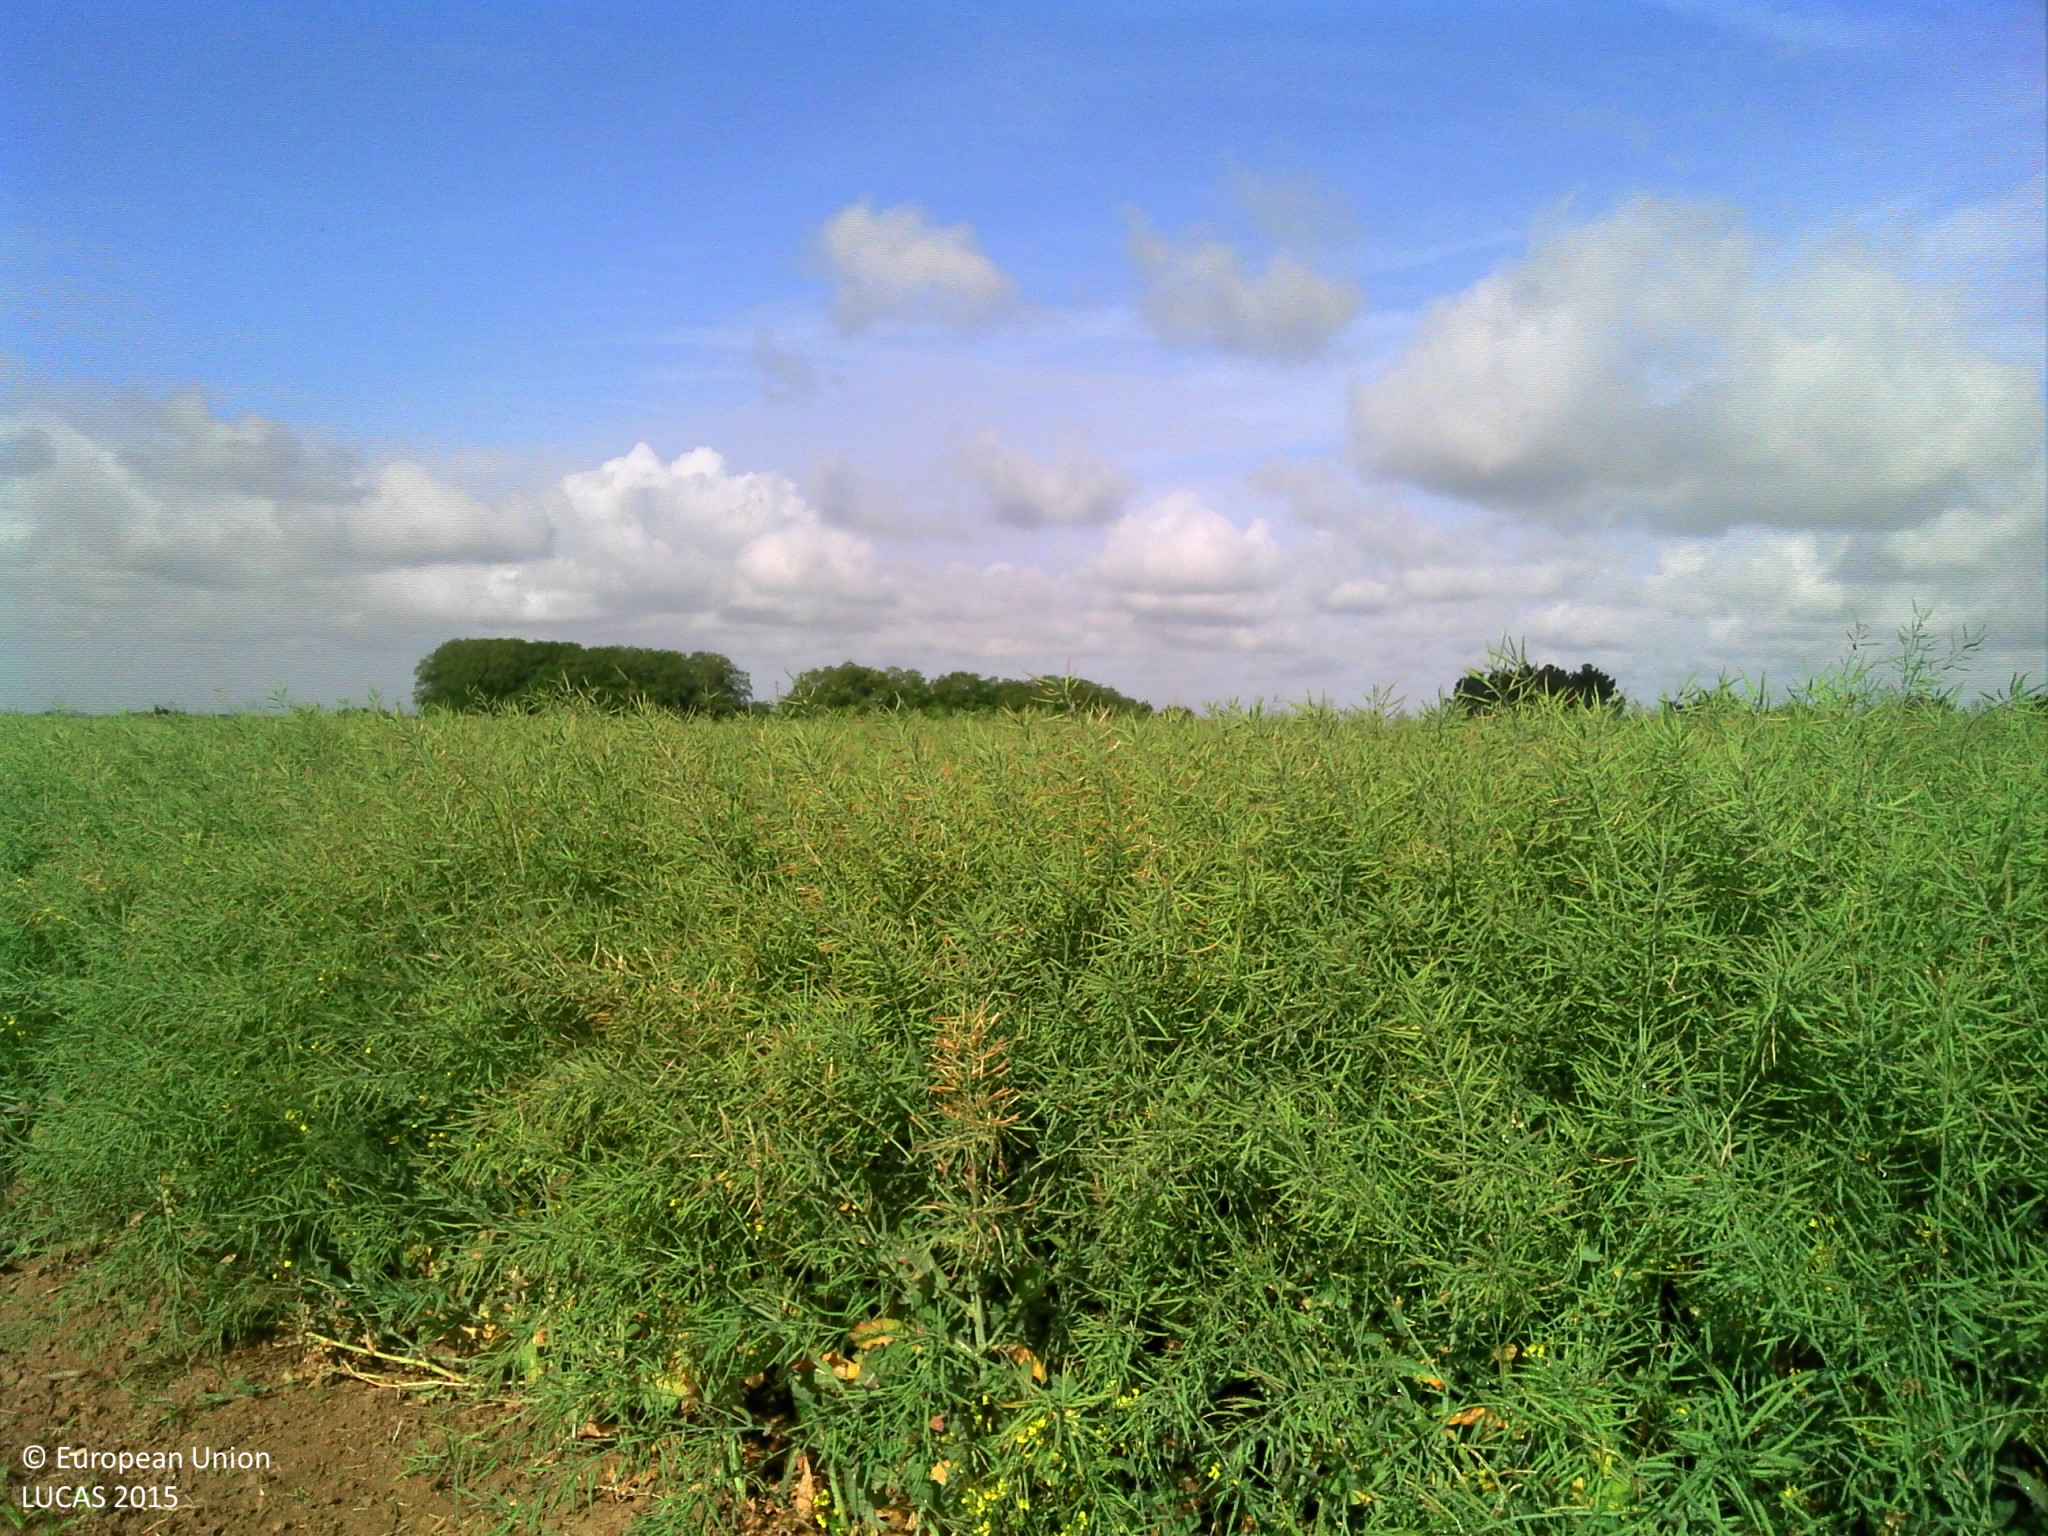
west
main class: Cropland
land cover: Rape and turnip rape
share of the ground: > 75 %
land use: Agriculture (excluding fallow land and kitchen gardens)
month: June
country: FR
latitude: 47.2425
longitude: 1.0400
